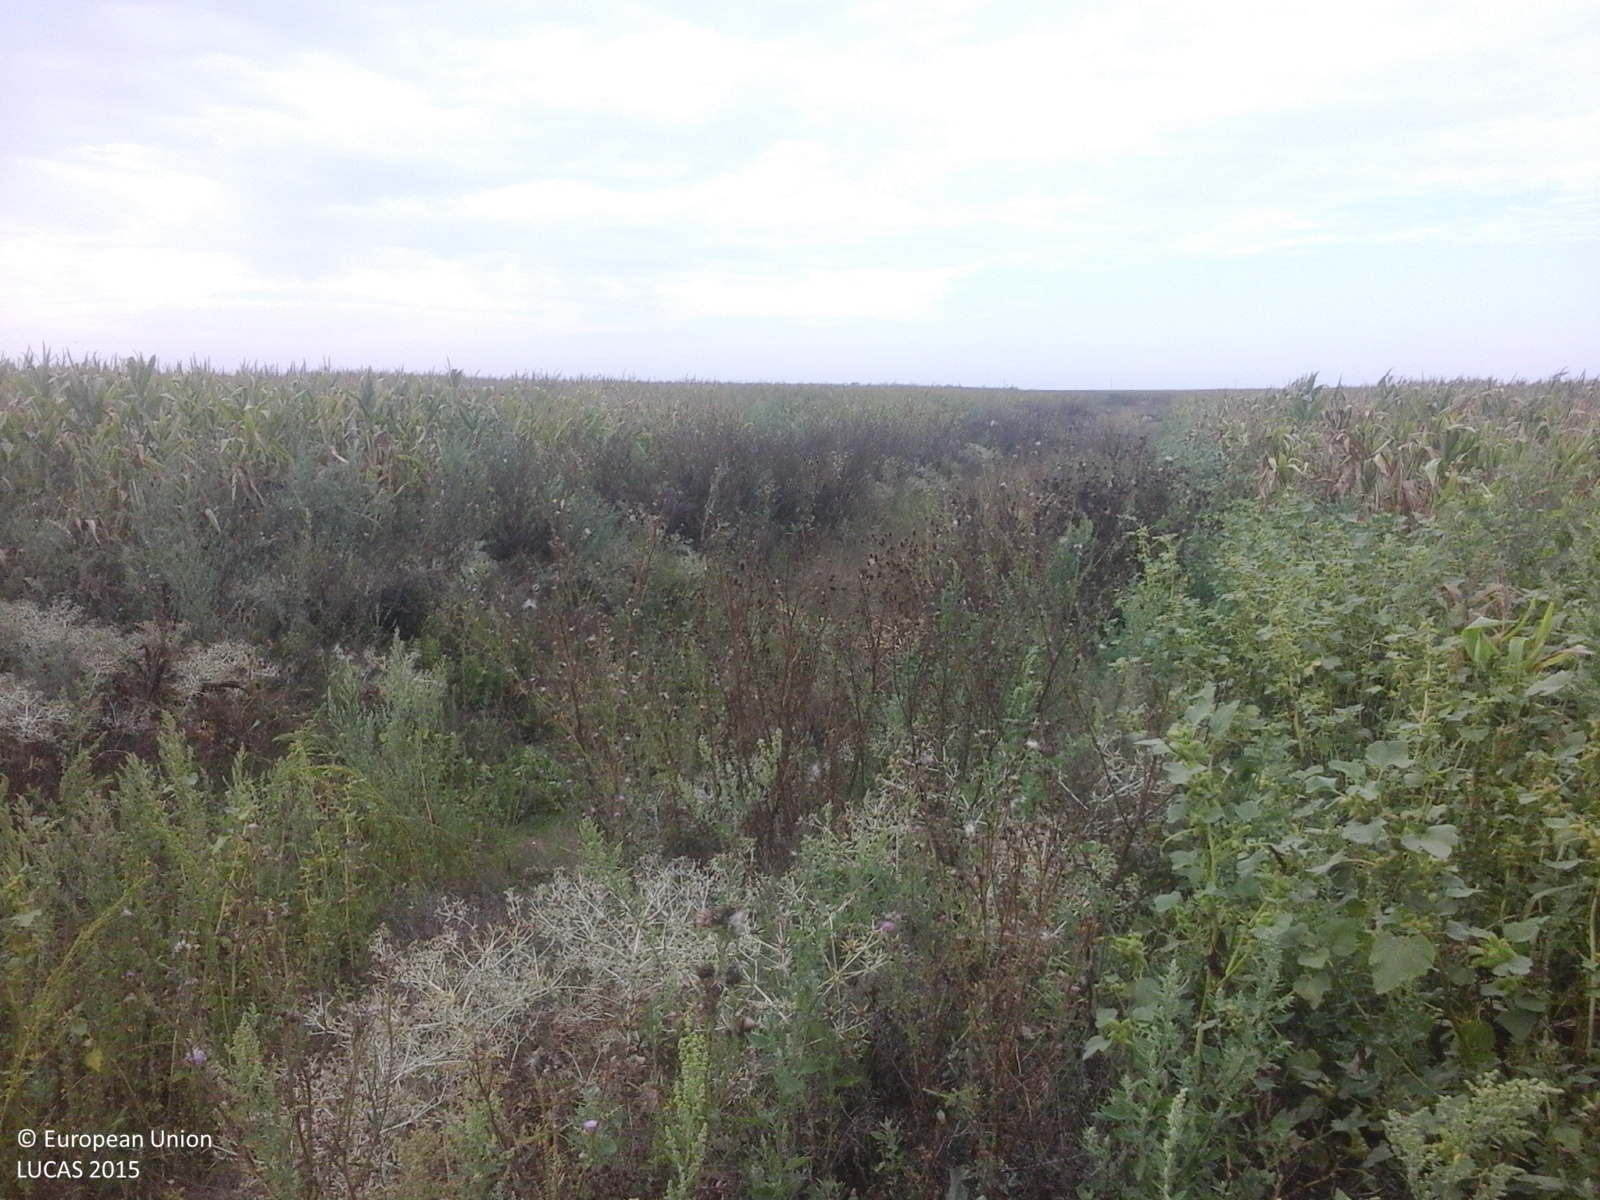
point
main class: Cropland
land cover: Maize
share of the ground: > 75 %
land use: Agriculture (excluding fallow land and kitchen gardens)
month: August
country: RO
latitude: 46.3364
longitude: 21.4295
